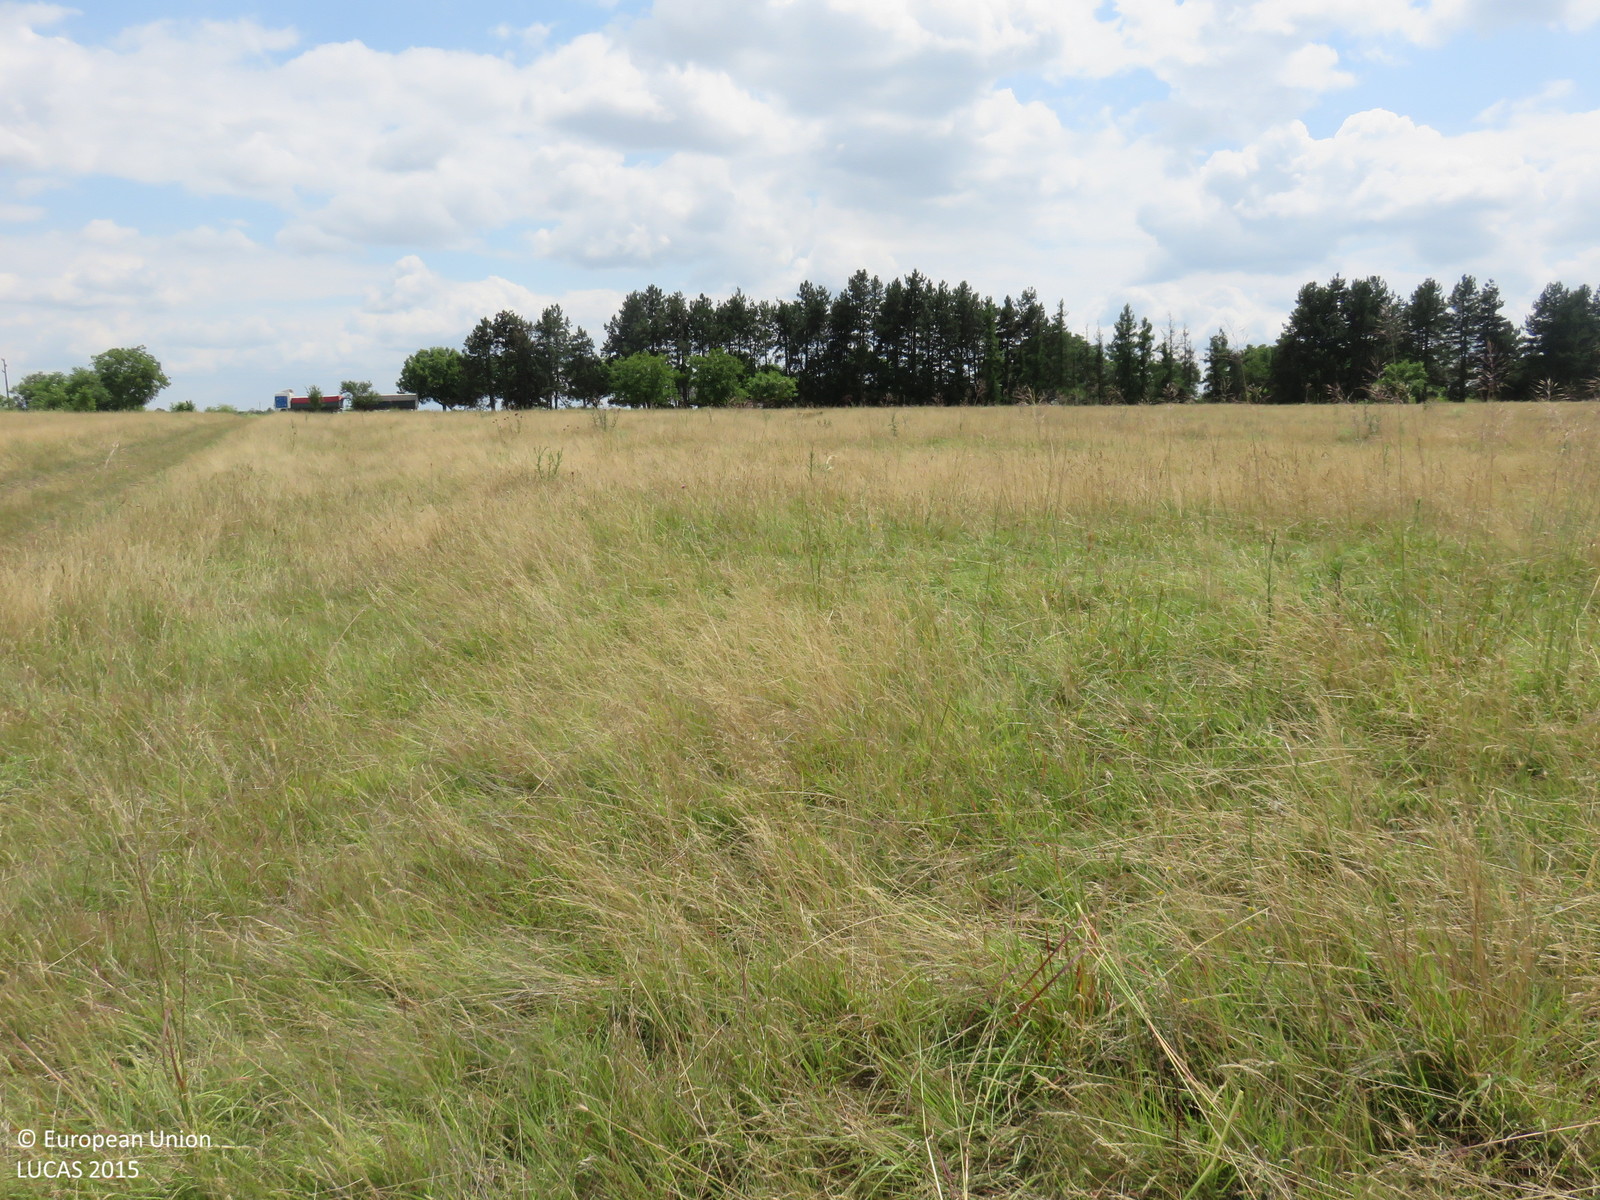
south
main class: Grassland
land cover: Grassland without tree/shrub cover
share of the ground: > 75 %
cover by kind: herbaceous plants 100 %
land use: Agriculture (excluding fallow land and kitchen gardens)
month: June
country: BG
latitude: 43.4318
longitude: 24.9053
